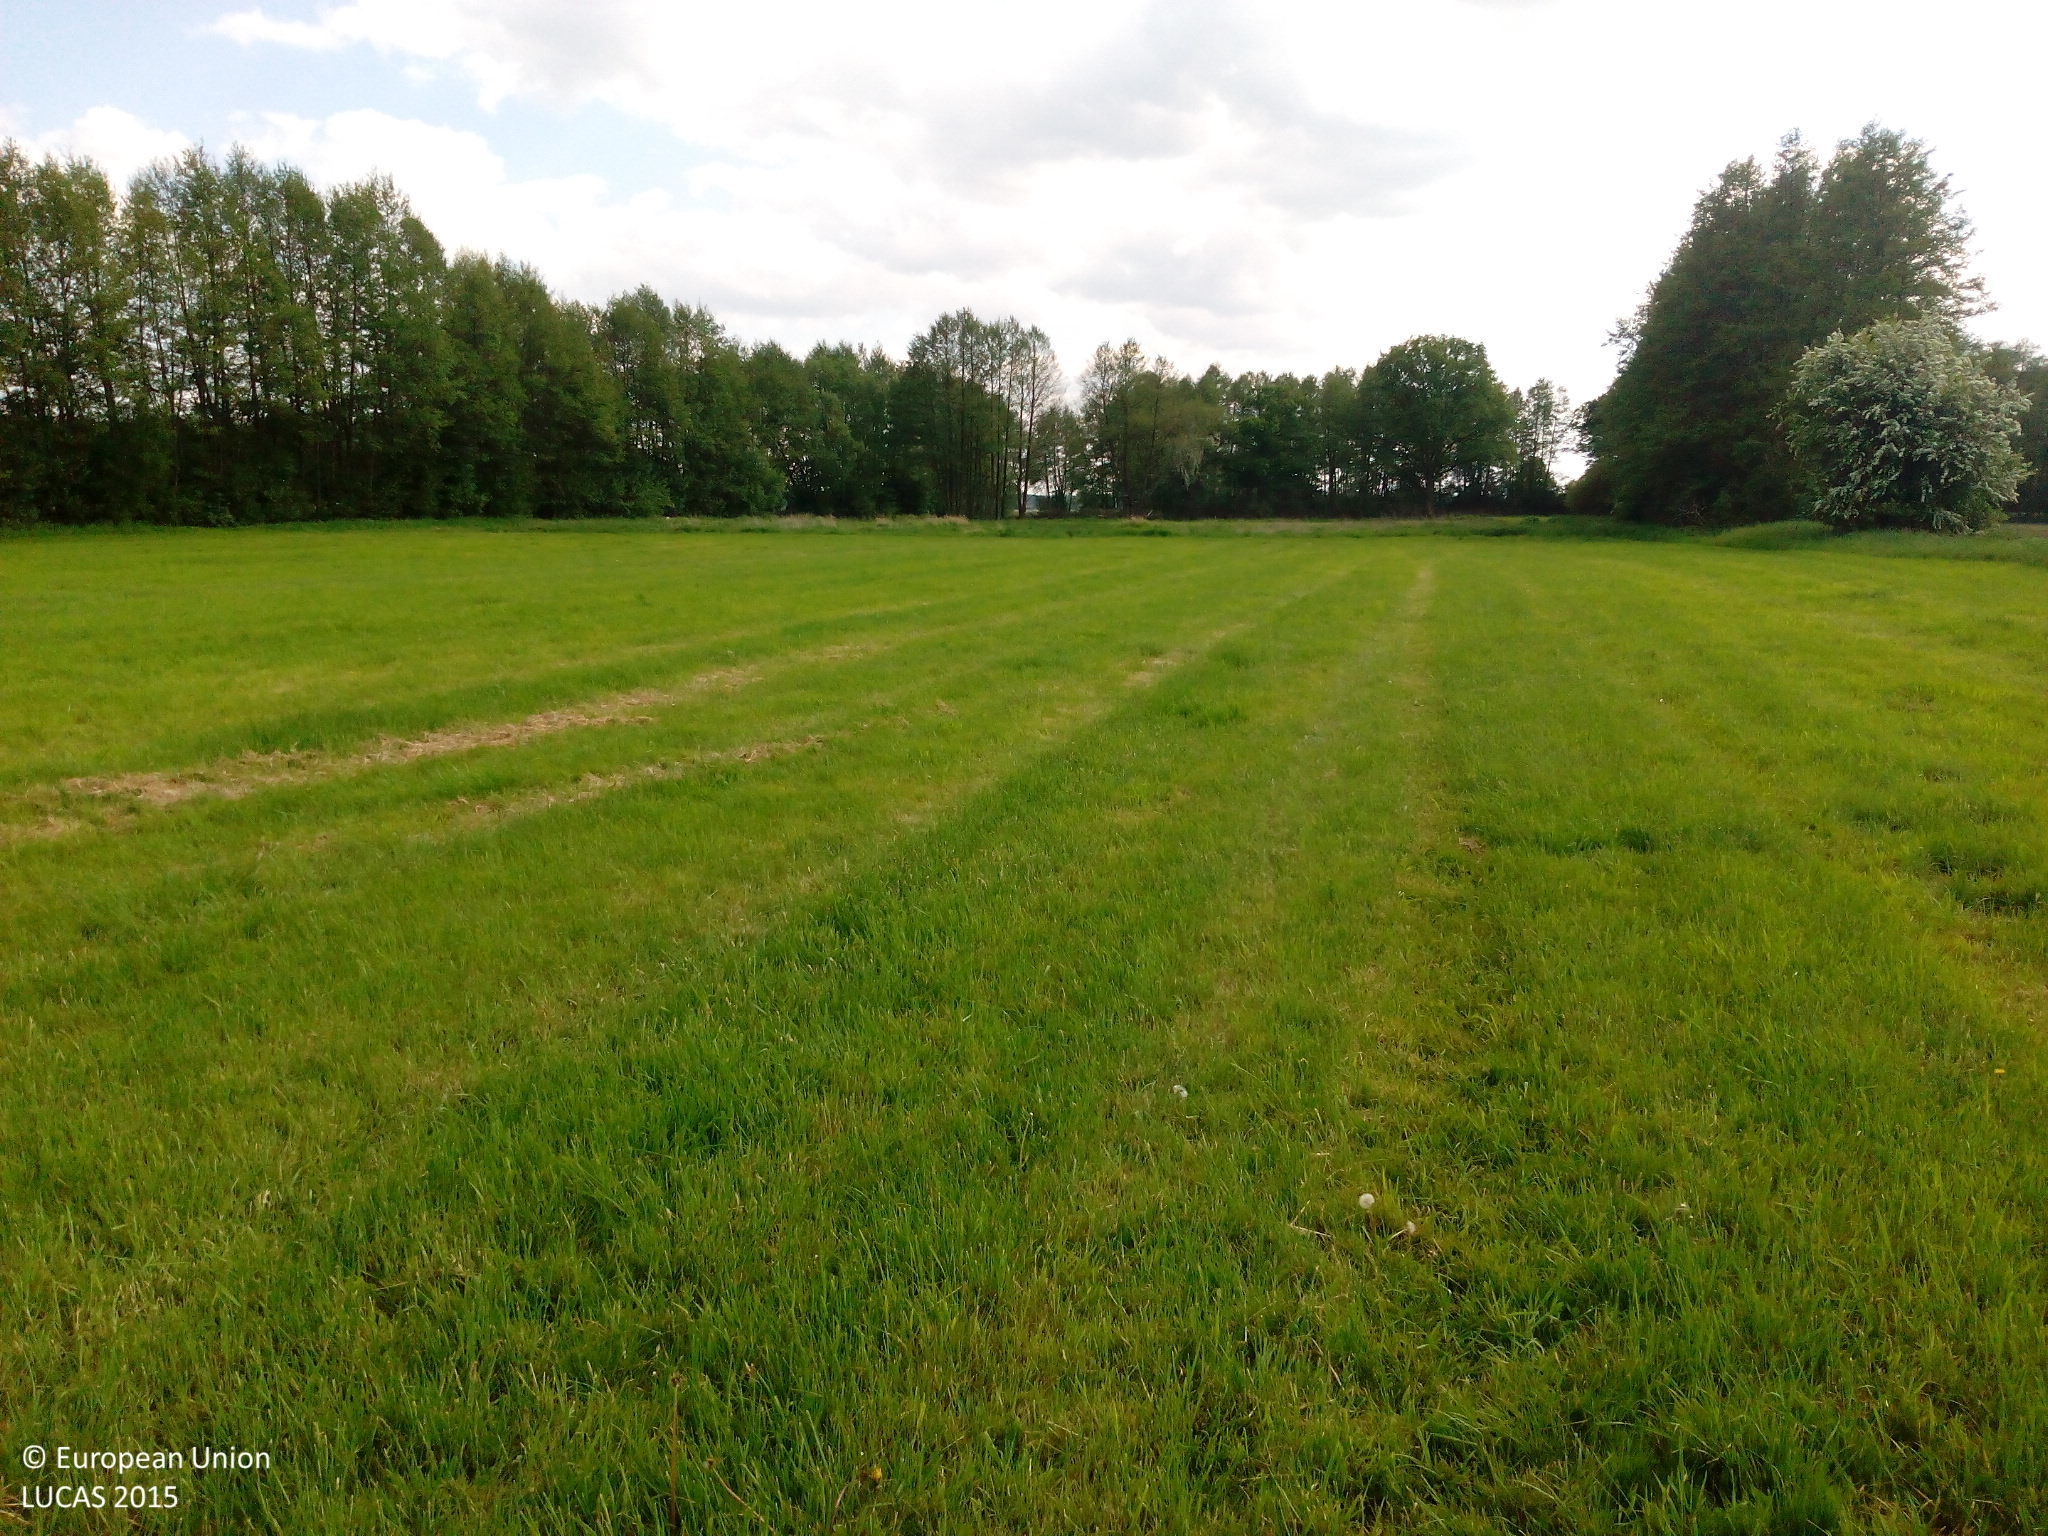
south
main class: Grassland
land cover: Grassland without tree/shrub cover
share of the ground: > 75 %
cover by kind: herbaceous plants 95 %, unconsolidated bare surface 5 %
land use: Agriculture (excluding fallow land and kitchen gardens)
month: May
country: DE
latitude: 52.8224
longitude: 11.0236
